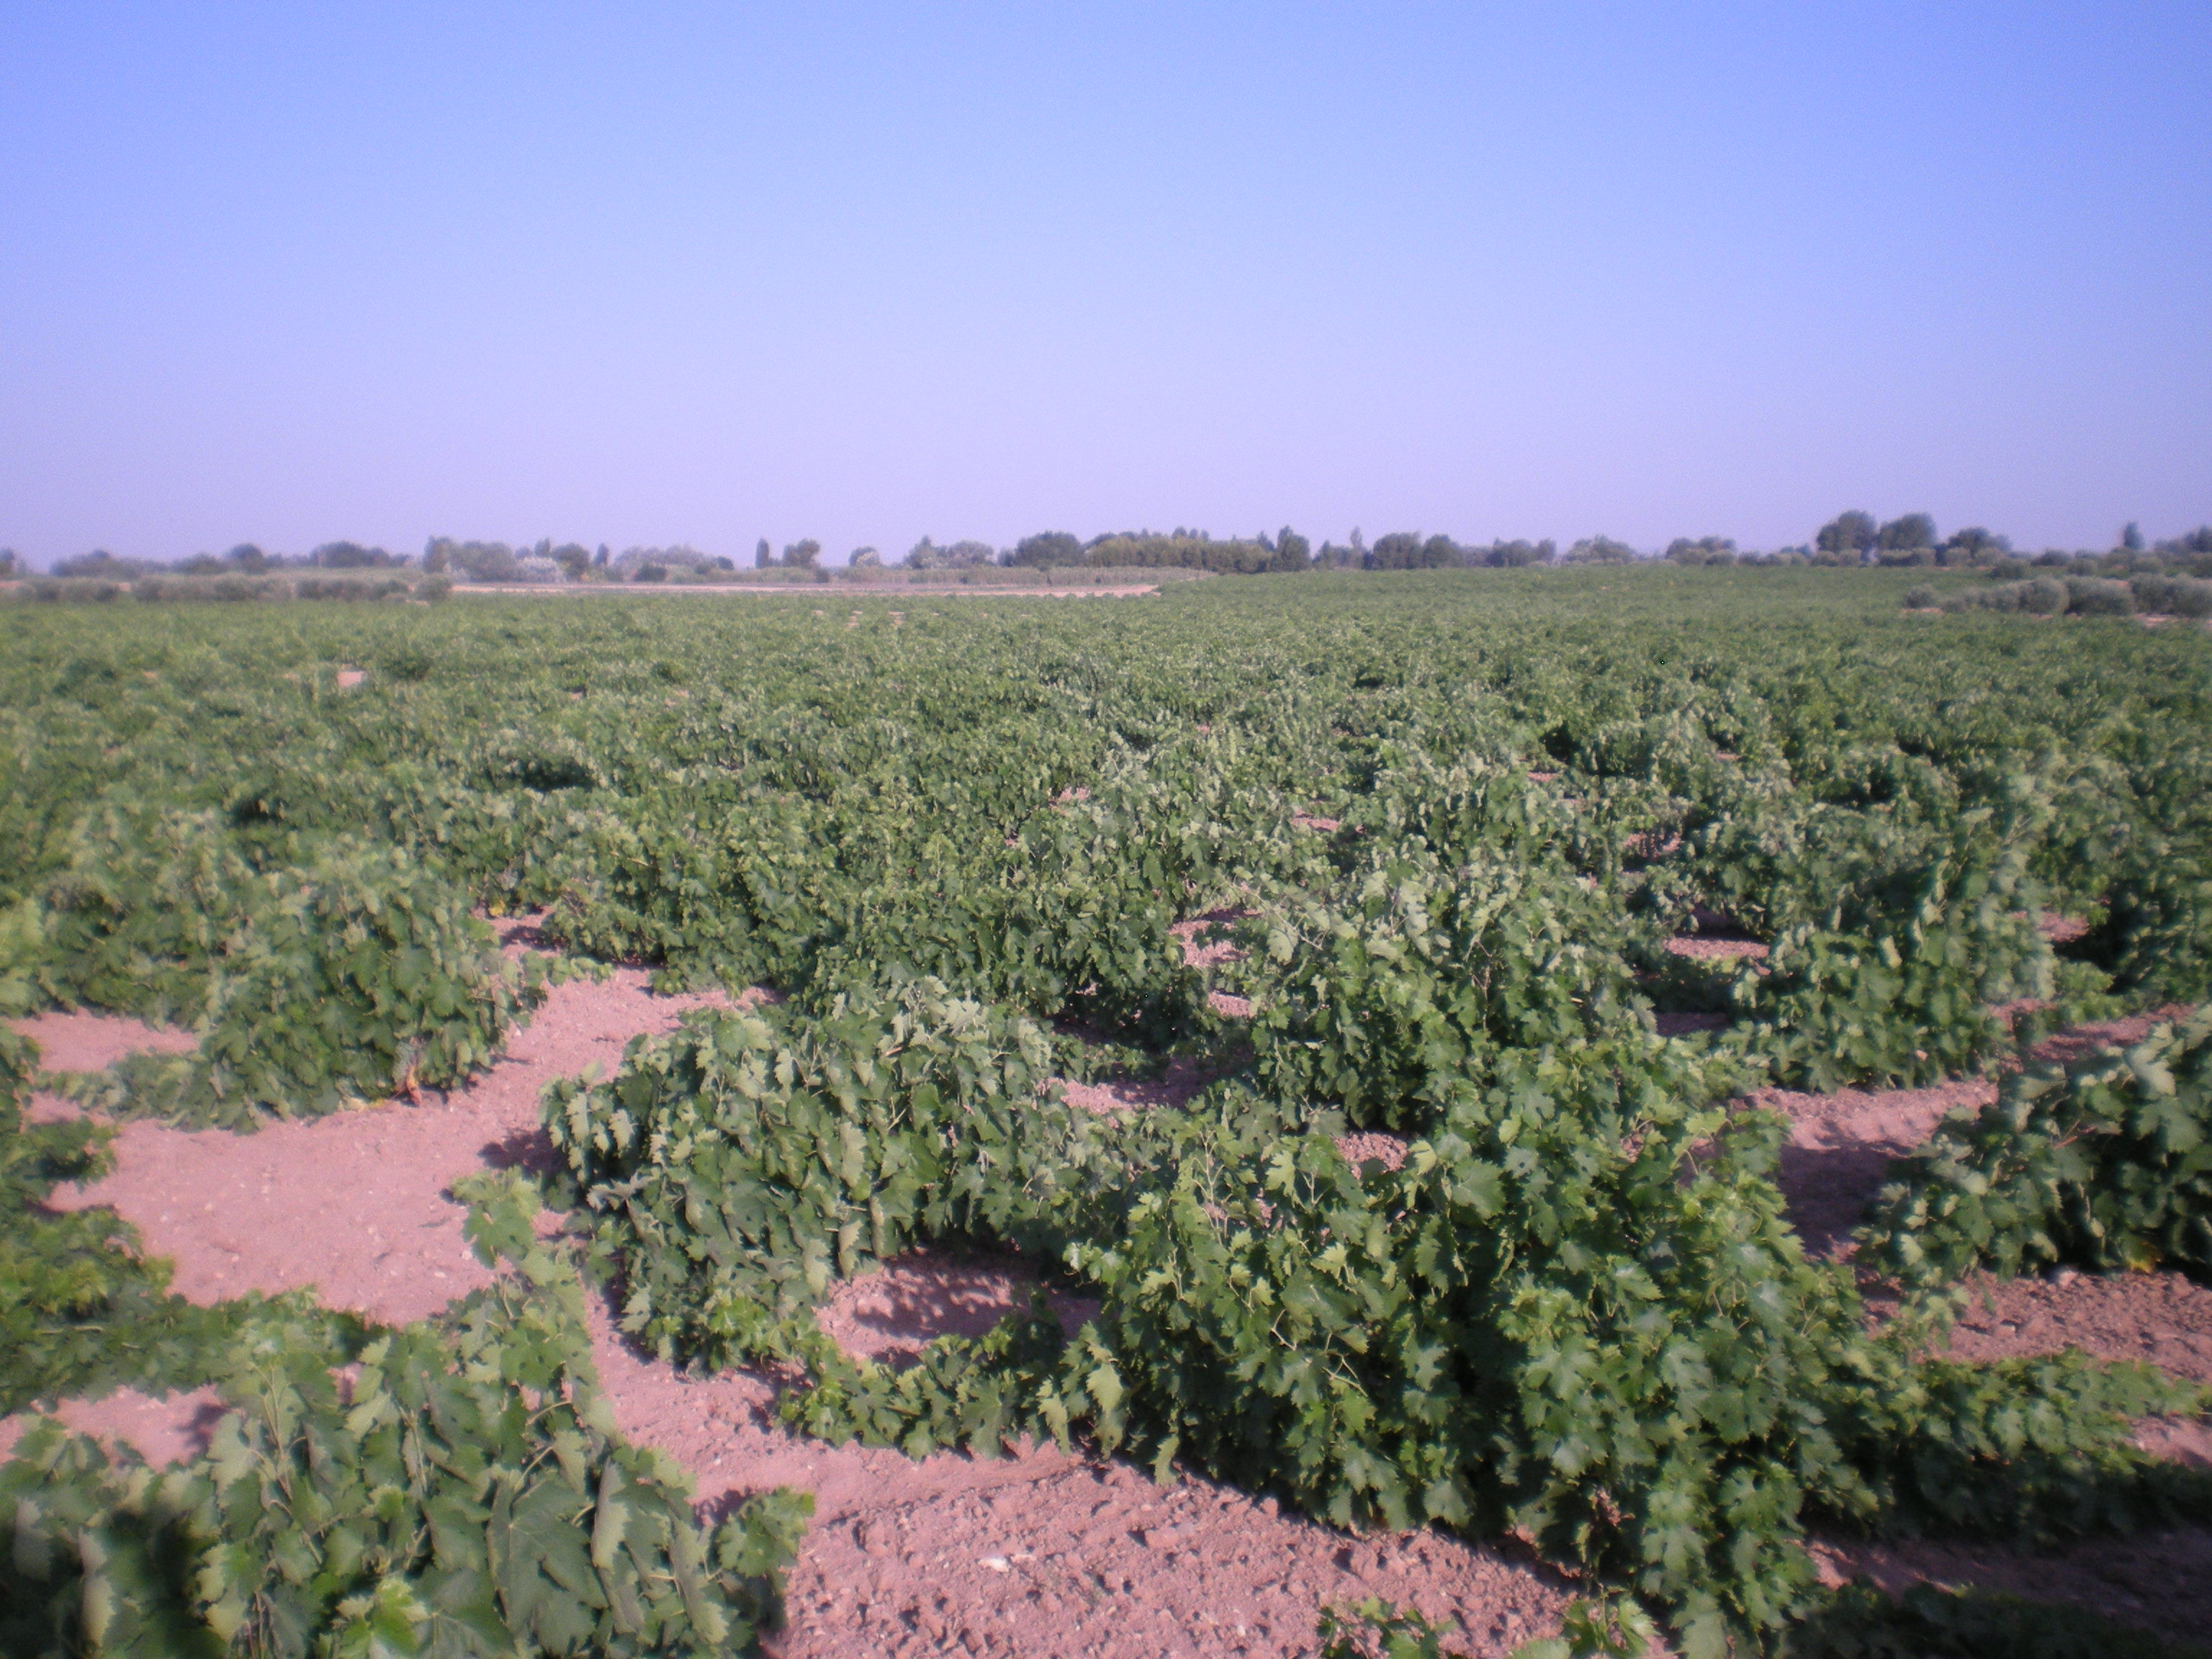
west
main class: Cropland
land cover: Vineyards
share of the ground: 25 - 50 %
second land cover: Other bare soil
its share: > 75 %
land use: Agriculture (excluding fallow land and kitchen gardens)
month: July
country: ES
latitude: 39.5775
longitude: -3.1636
